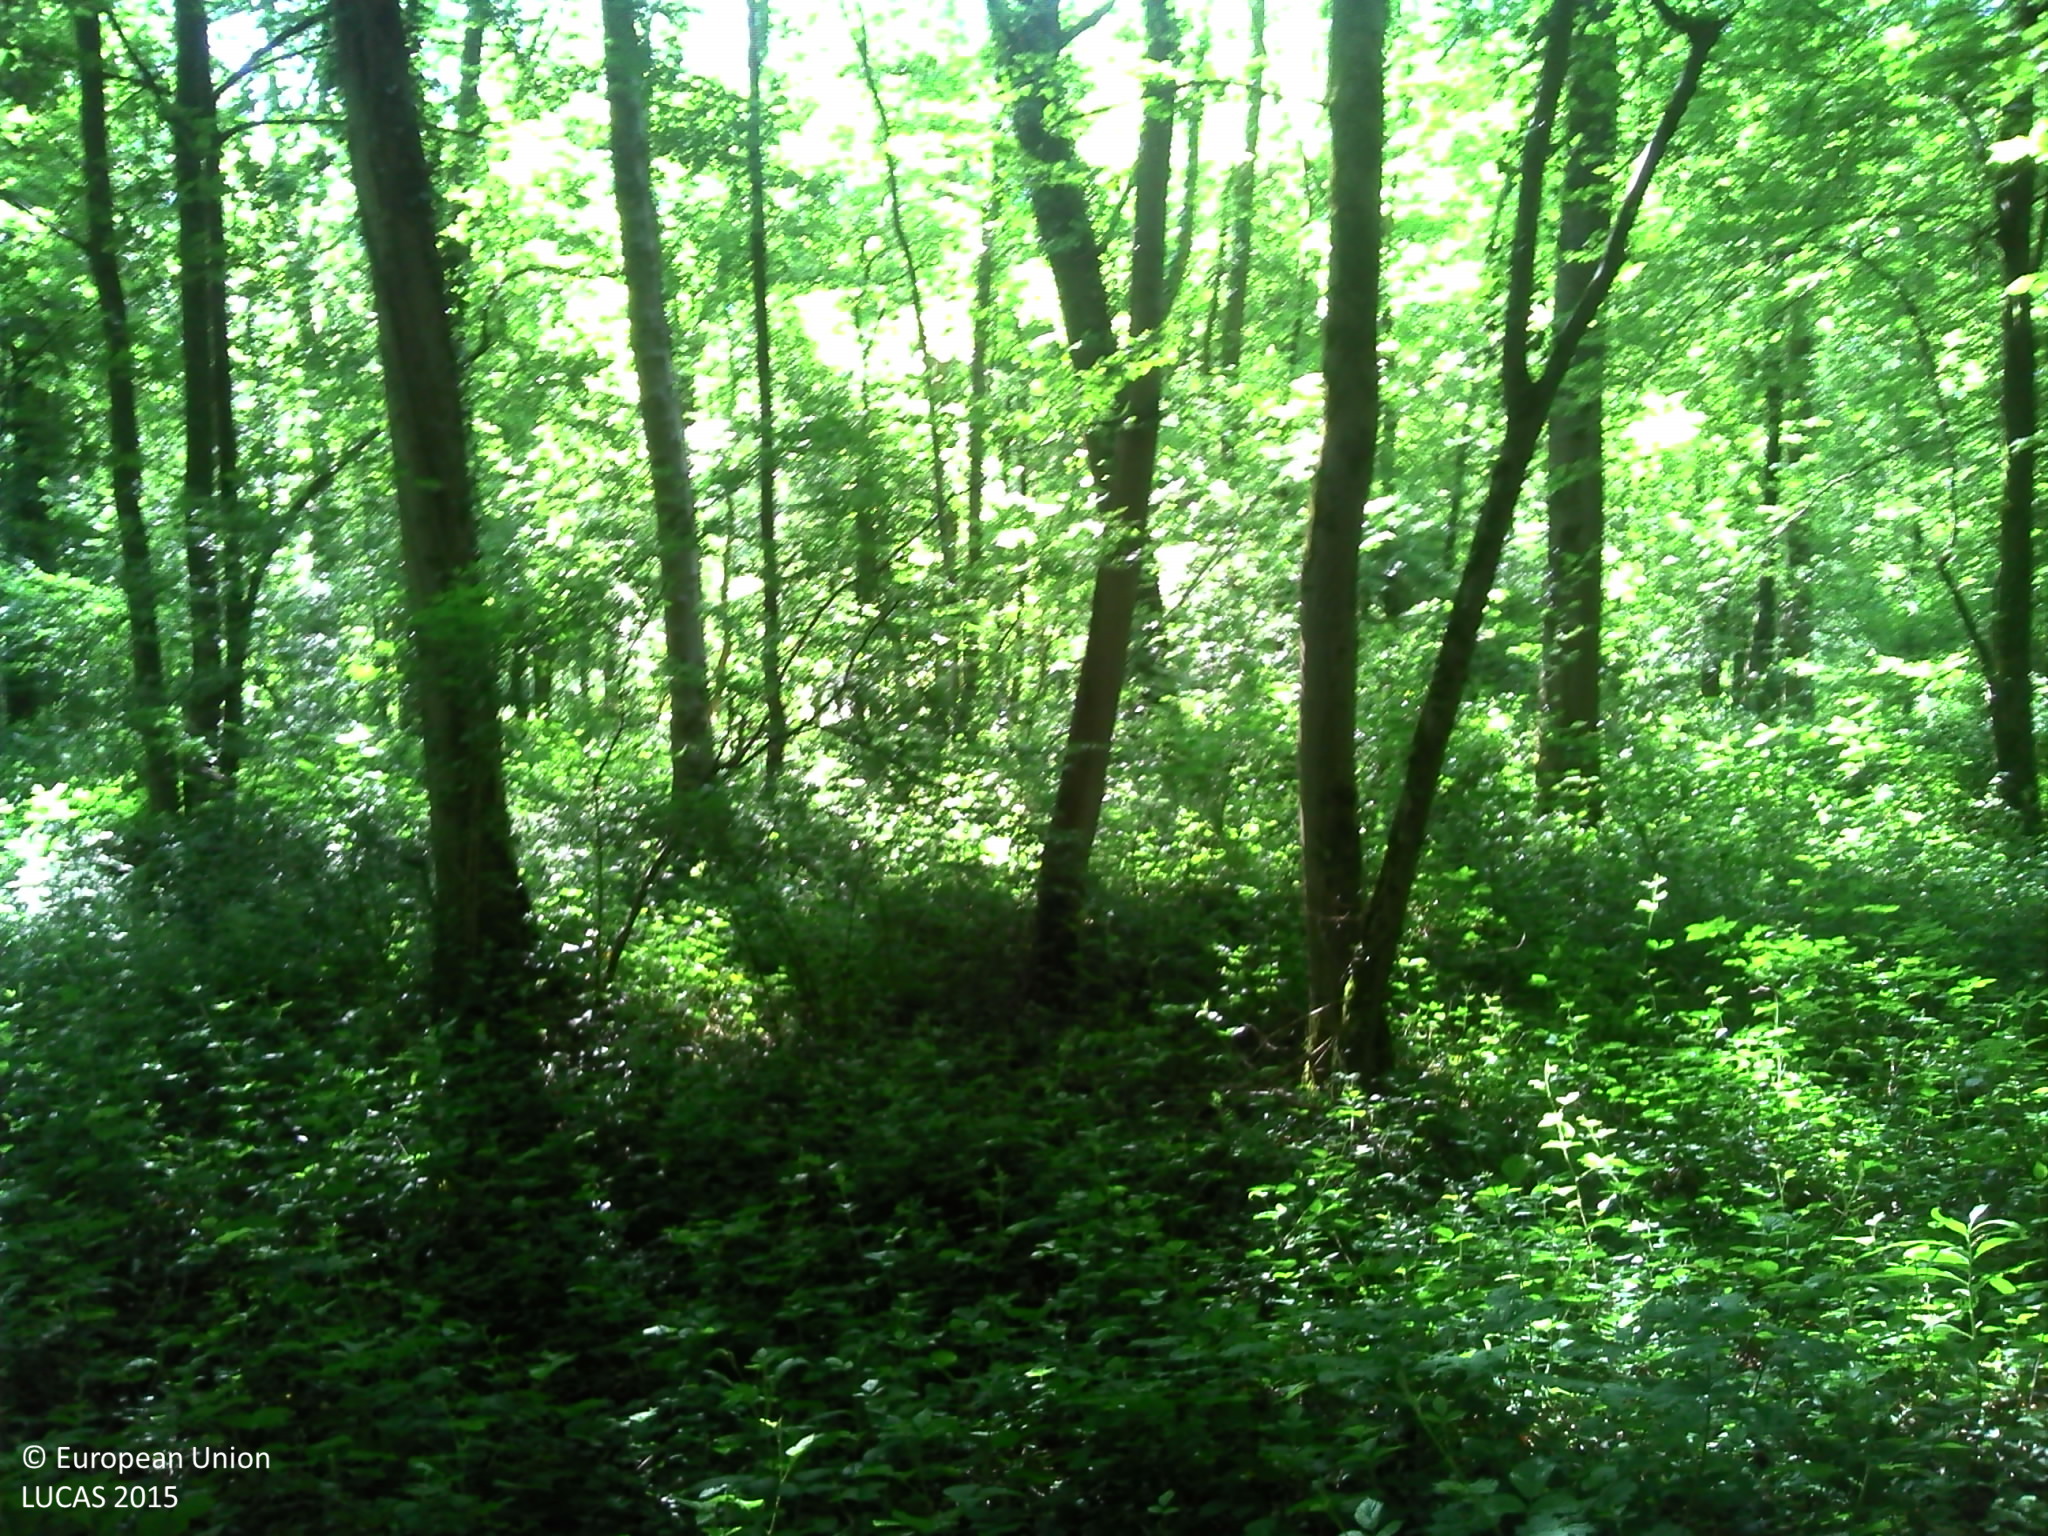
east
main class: Woodland
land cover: Broadleaved woodland
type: mesophytic deciduous forest
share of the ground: > 75 %
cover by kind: broadleaved forest trees 80 %, shrubs 10 %, herbaceous plants 10 %
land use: Forestry
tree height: > 5 m
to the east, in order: Broadleaved woodland; Grass margins; Paved roads, cycling and walking lanes; Grass margins; Broadleaved woodland
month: June
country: FR
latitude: 49.9399
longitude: 4.0729
